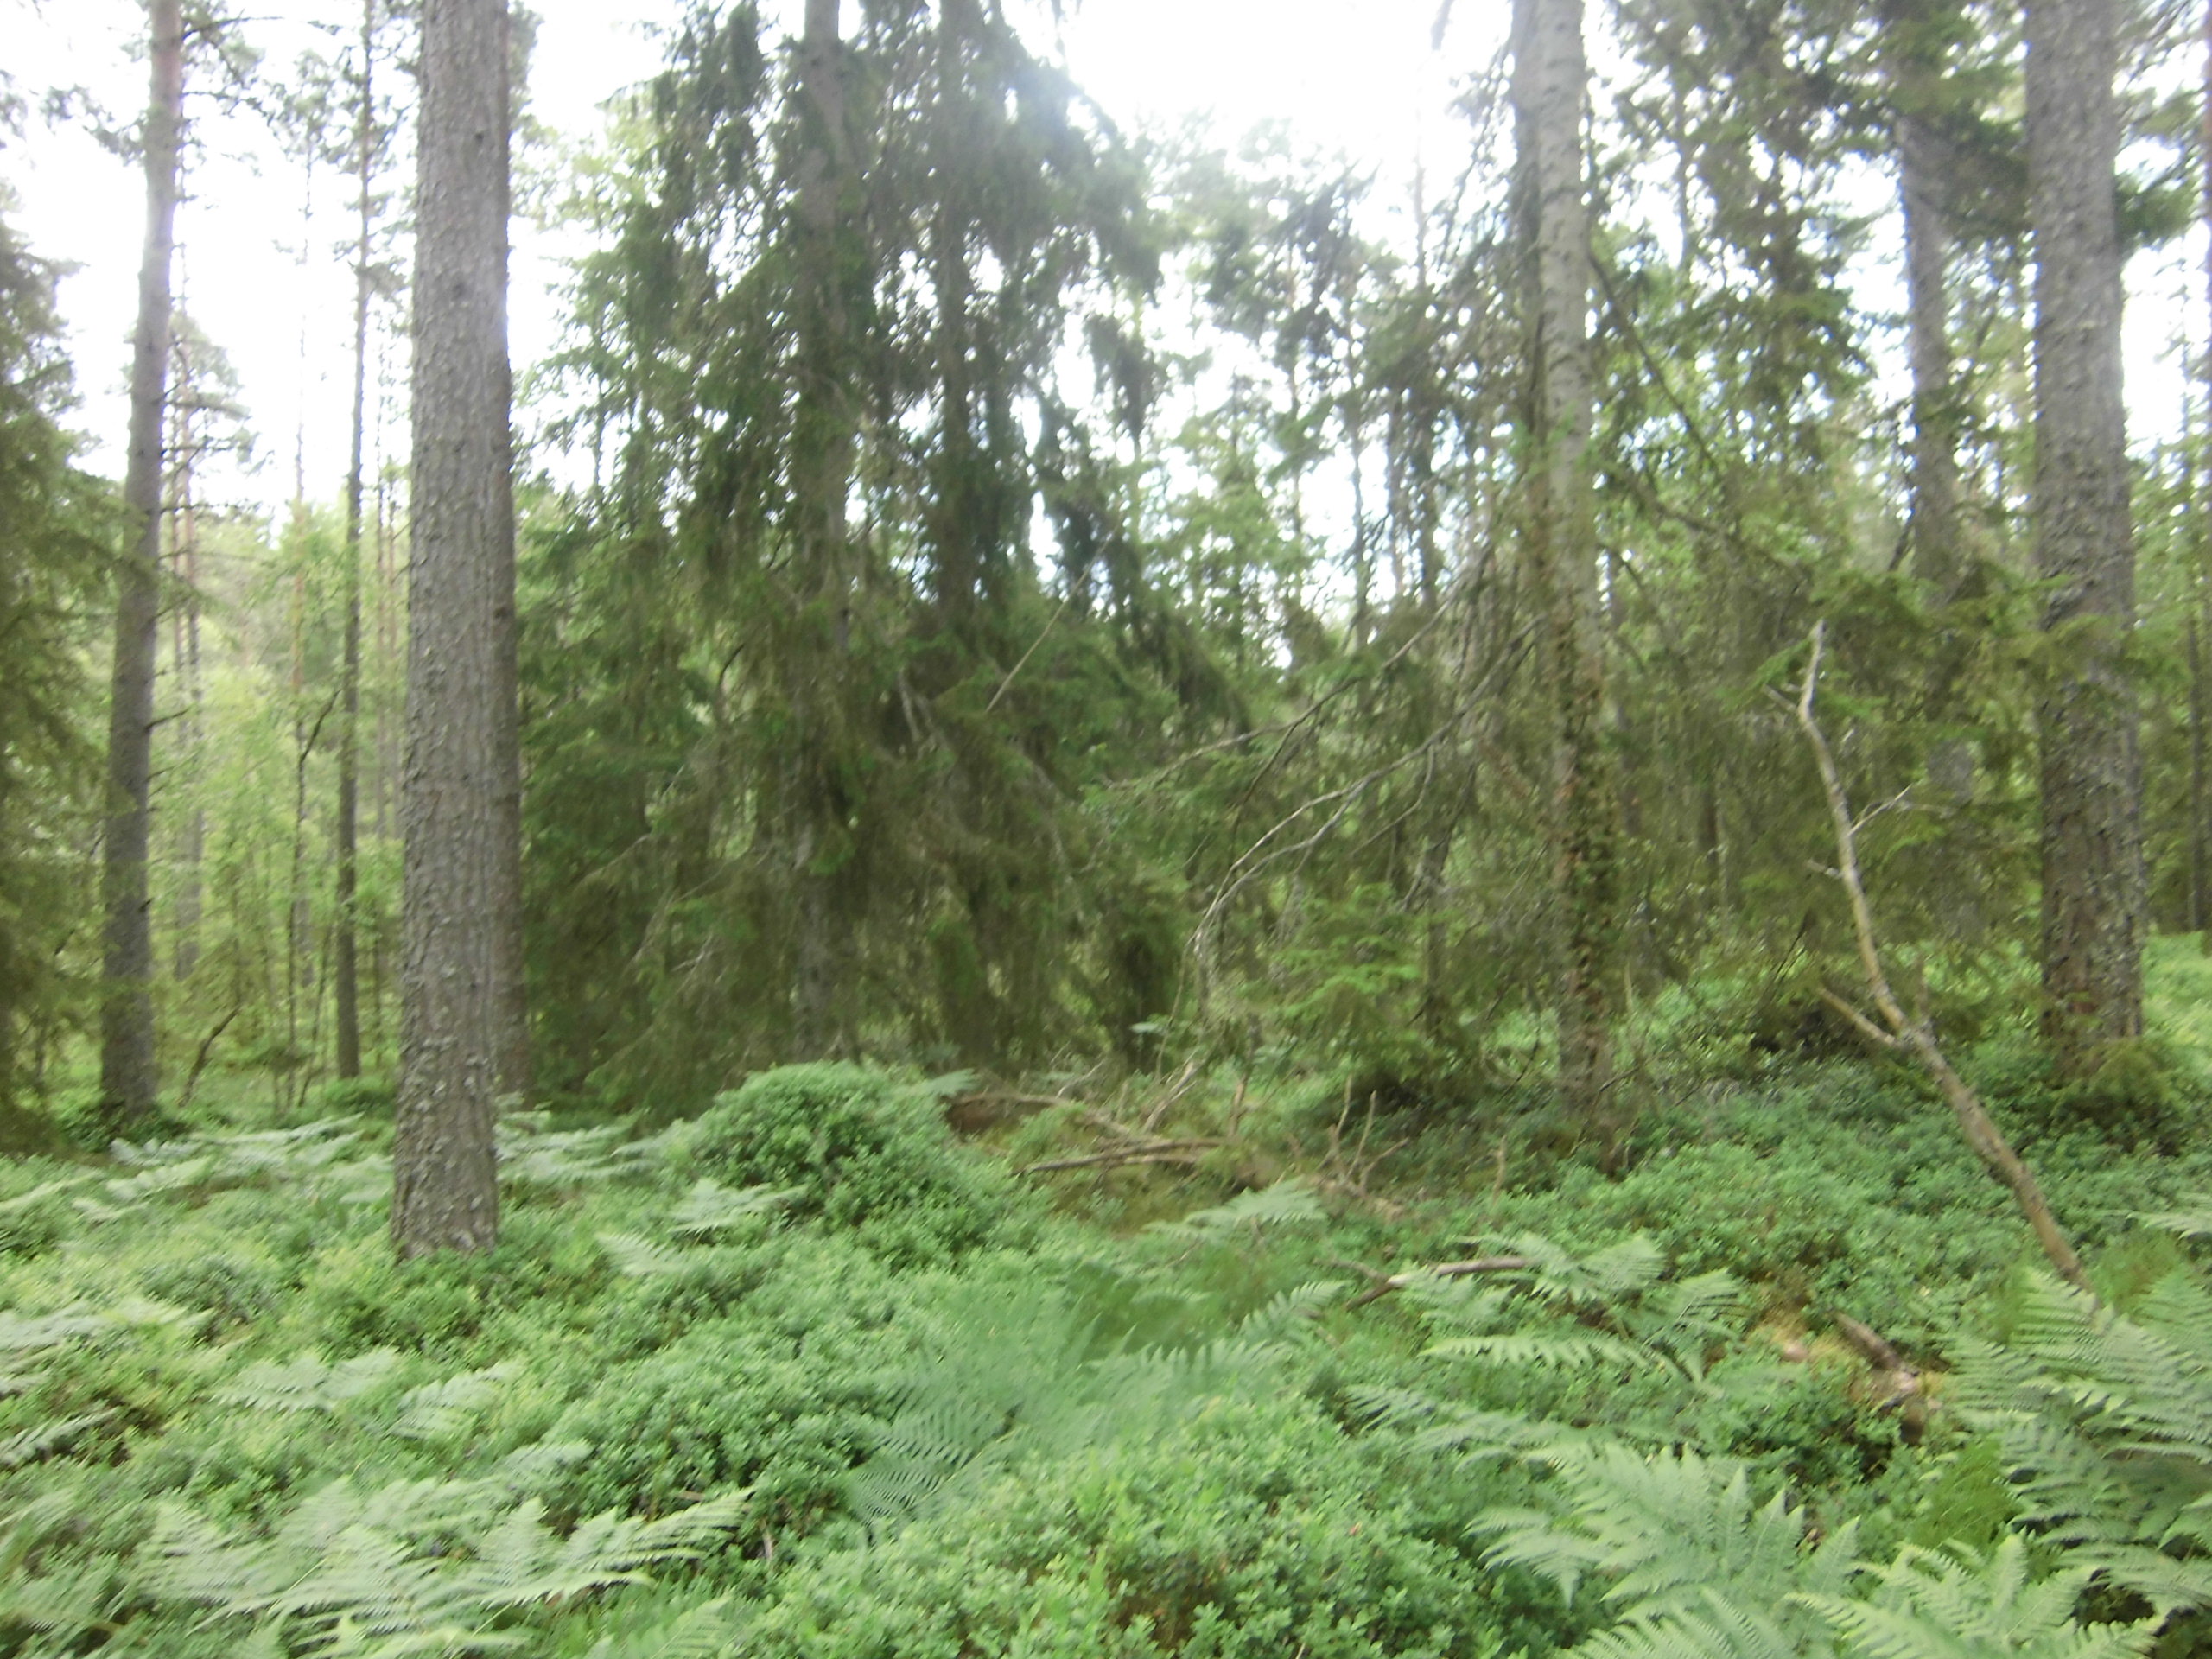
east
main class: Woodland
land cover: Pine dominated coniferous woodland
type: boreal forest
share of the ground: 50 - 75 %
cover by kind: coniferous forest trees 55 %, shrubs 30 %, broadleaved forest trees 5 %, herbaceous plants 5 %, lichens and mosses 5 %
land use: Forestry
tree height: > 5 m
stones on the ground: 25 - 50 %
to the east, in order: Pine dominated coniferous woodland
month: July
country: SE
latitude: 57.2696
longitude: 15.2537
